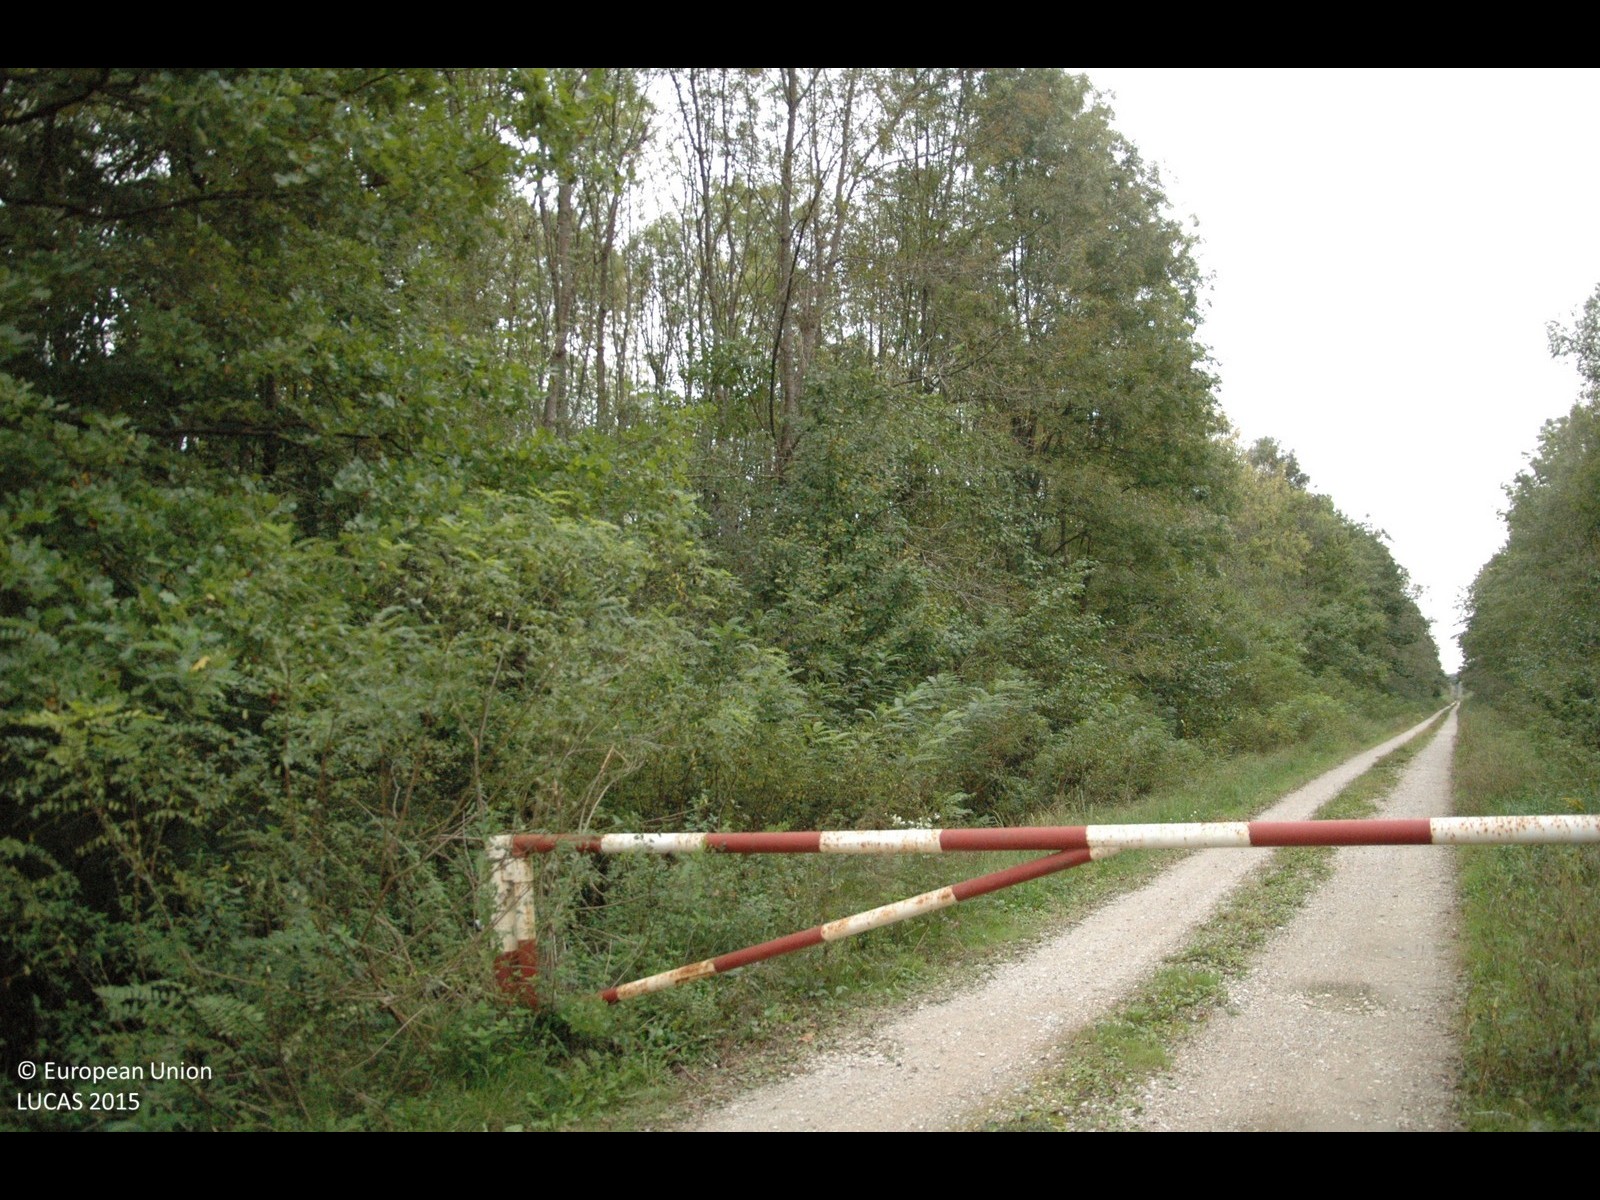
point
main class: Woodland
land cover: Broadleaved woodland
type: floodplain forest
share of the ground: > 75 %
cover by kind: broadleaved forest trees 100 %
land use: Forestry
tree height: > 5 m
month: October
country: HR
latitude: 45.5714
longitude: 16.2638
